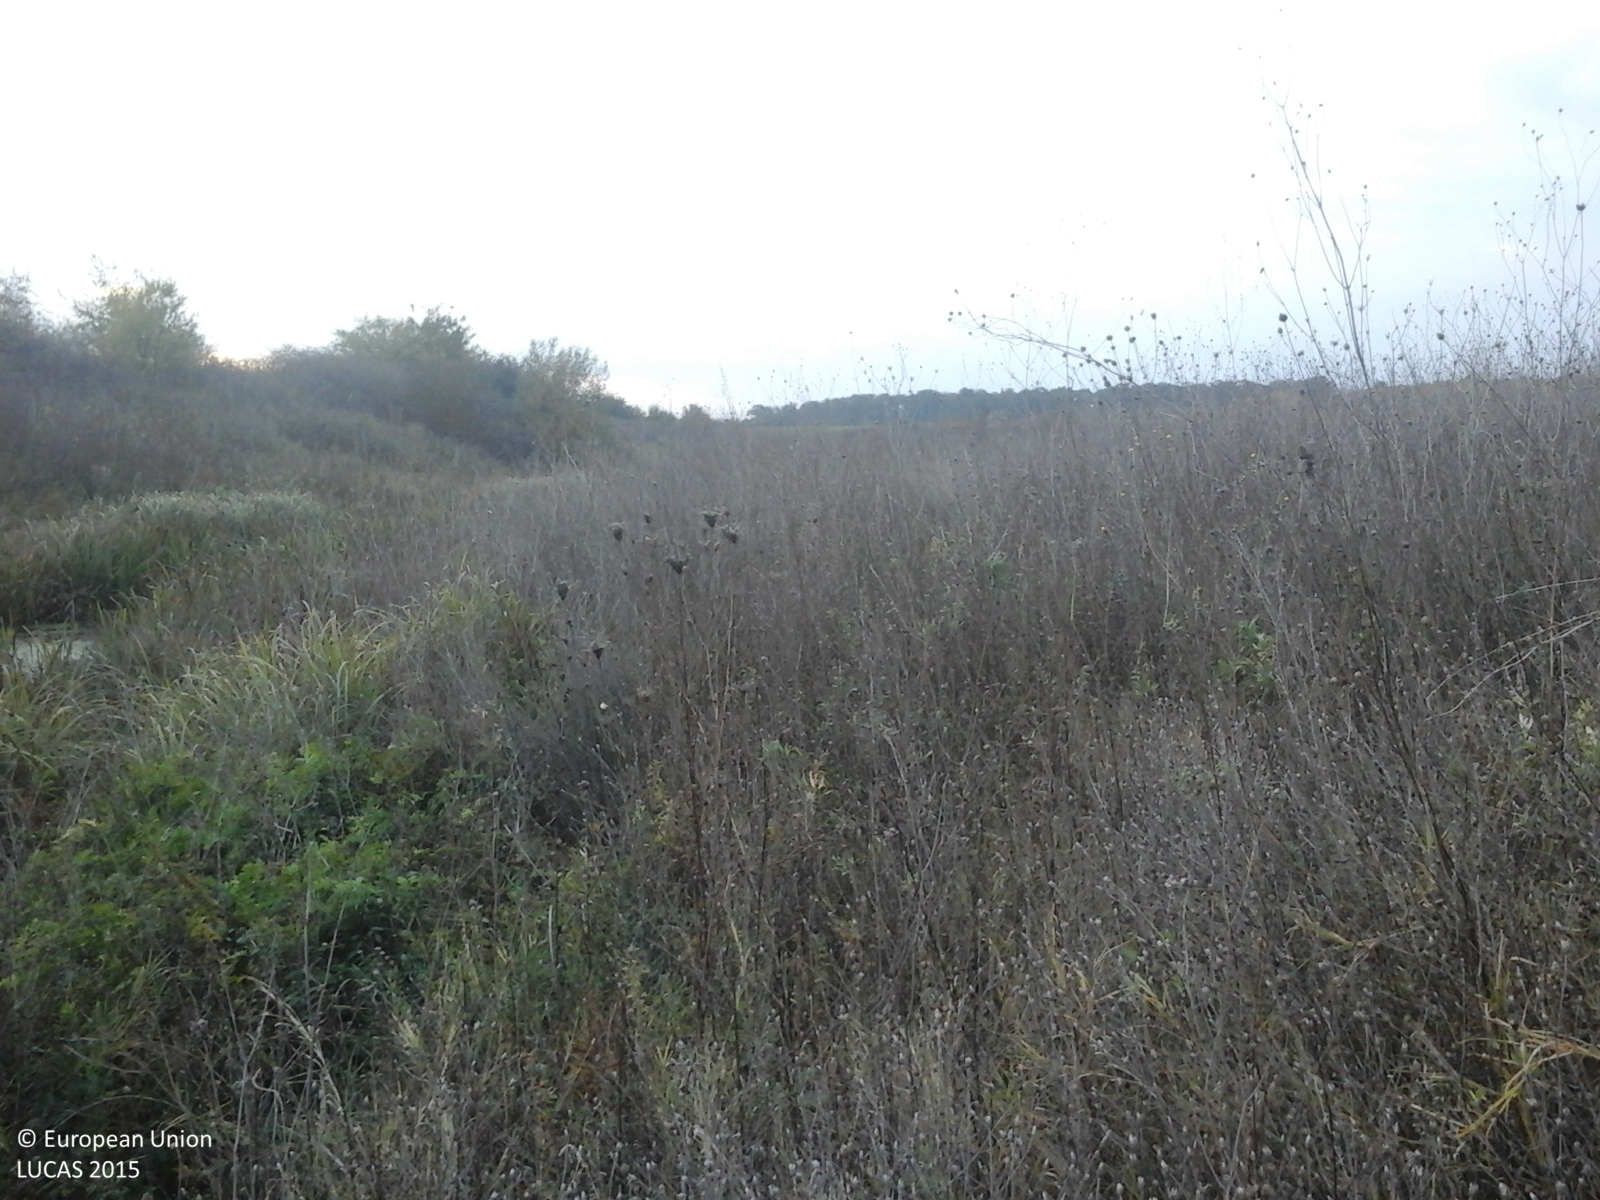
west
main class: Grassland
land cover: Spontaneously vegetated surfaces
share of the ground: > 75 %
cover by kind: herbaceous plants 100 %
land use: Fallow land
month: October
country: RO
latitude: 44.6975
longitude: 25.9932
